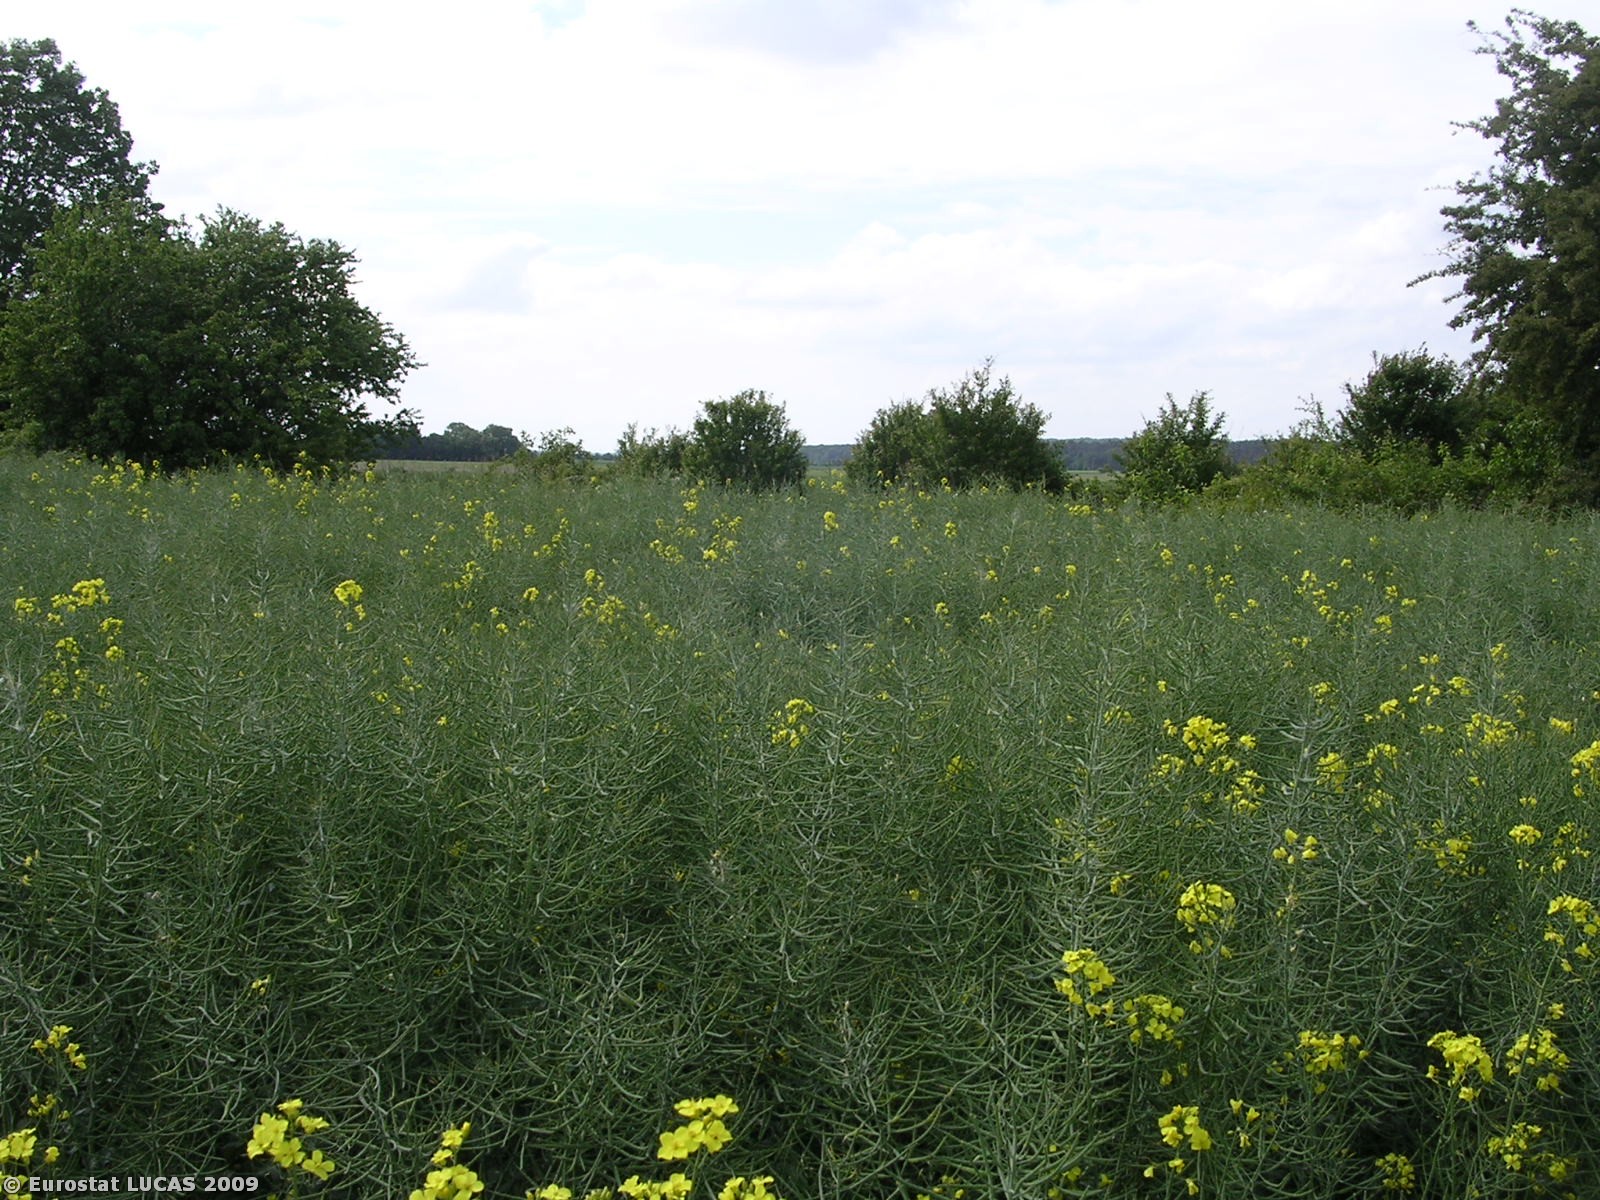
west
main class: Cropland
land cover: Rape and turnip rape
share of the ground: > 75 %
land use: Agriculture (excluding fallow land and kitchen gardens)
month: May
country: CZ
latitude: 50.2759
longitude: 14.9278
